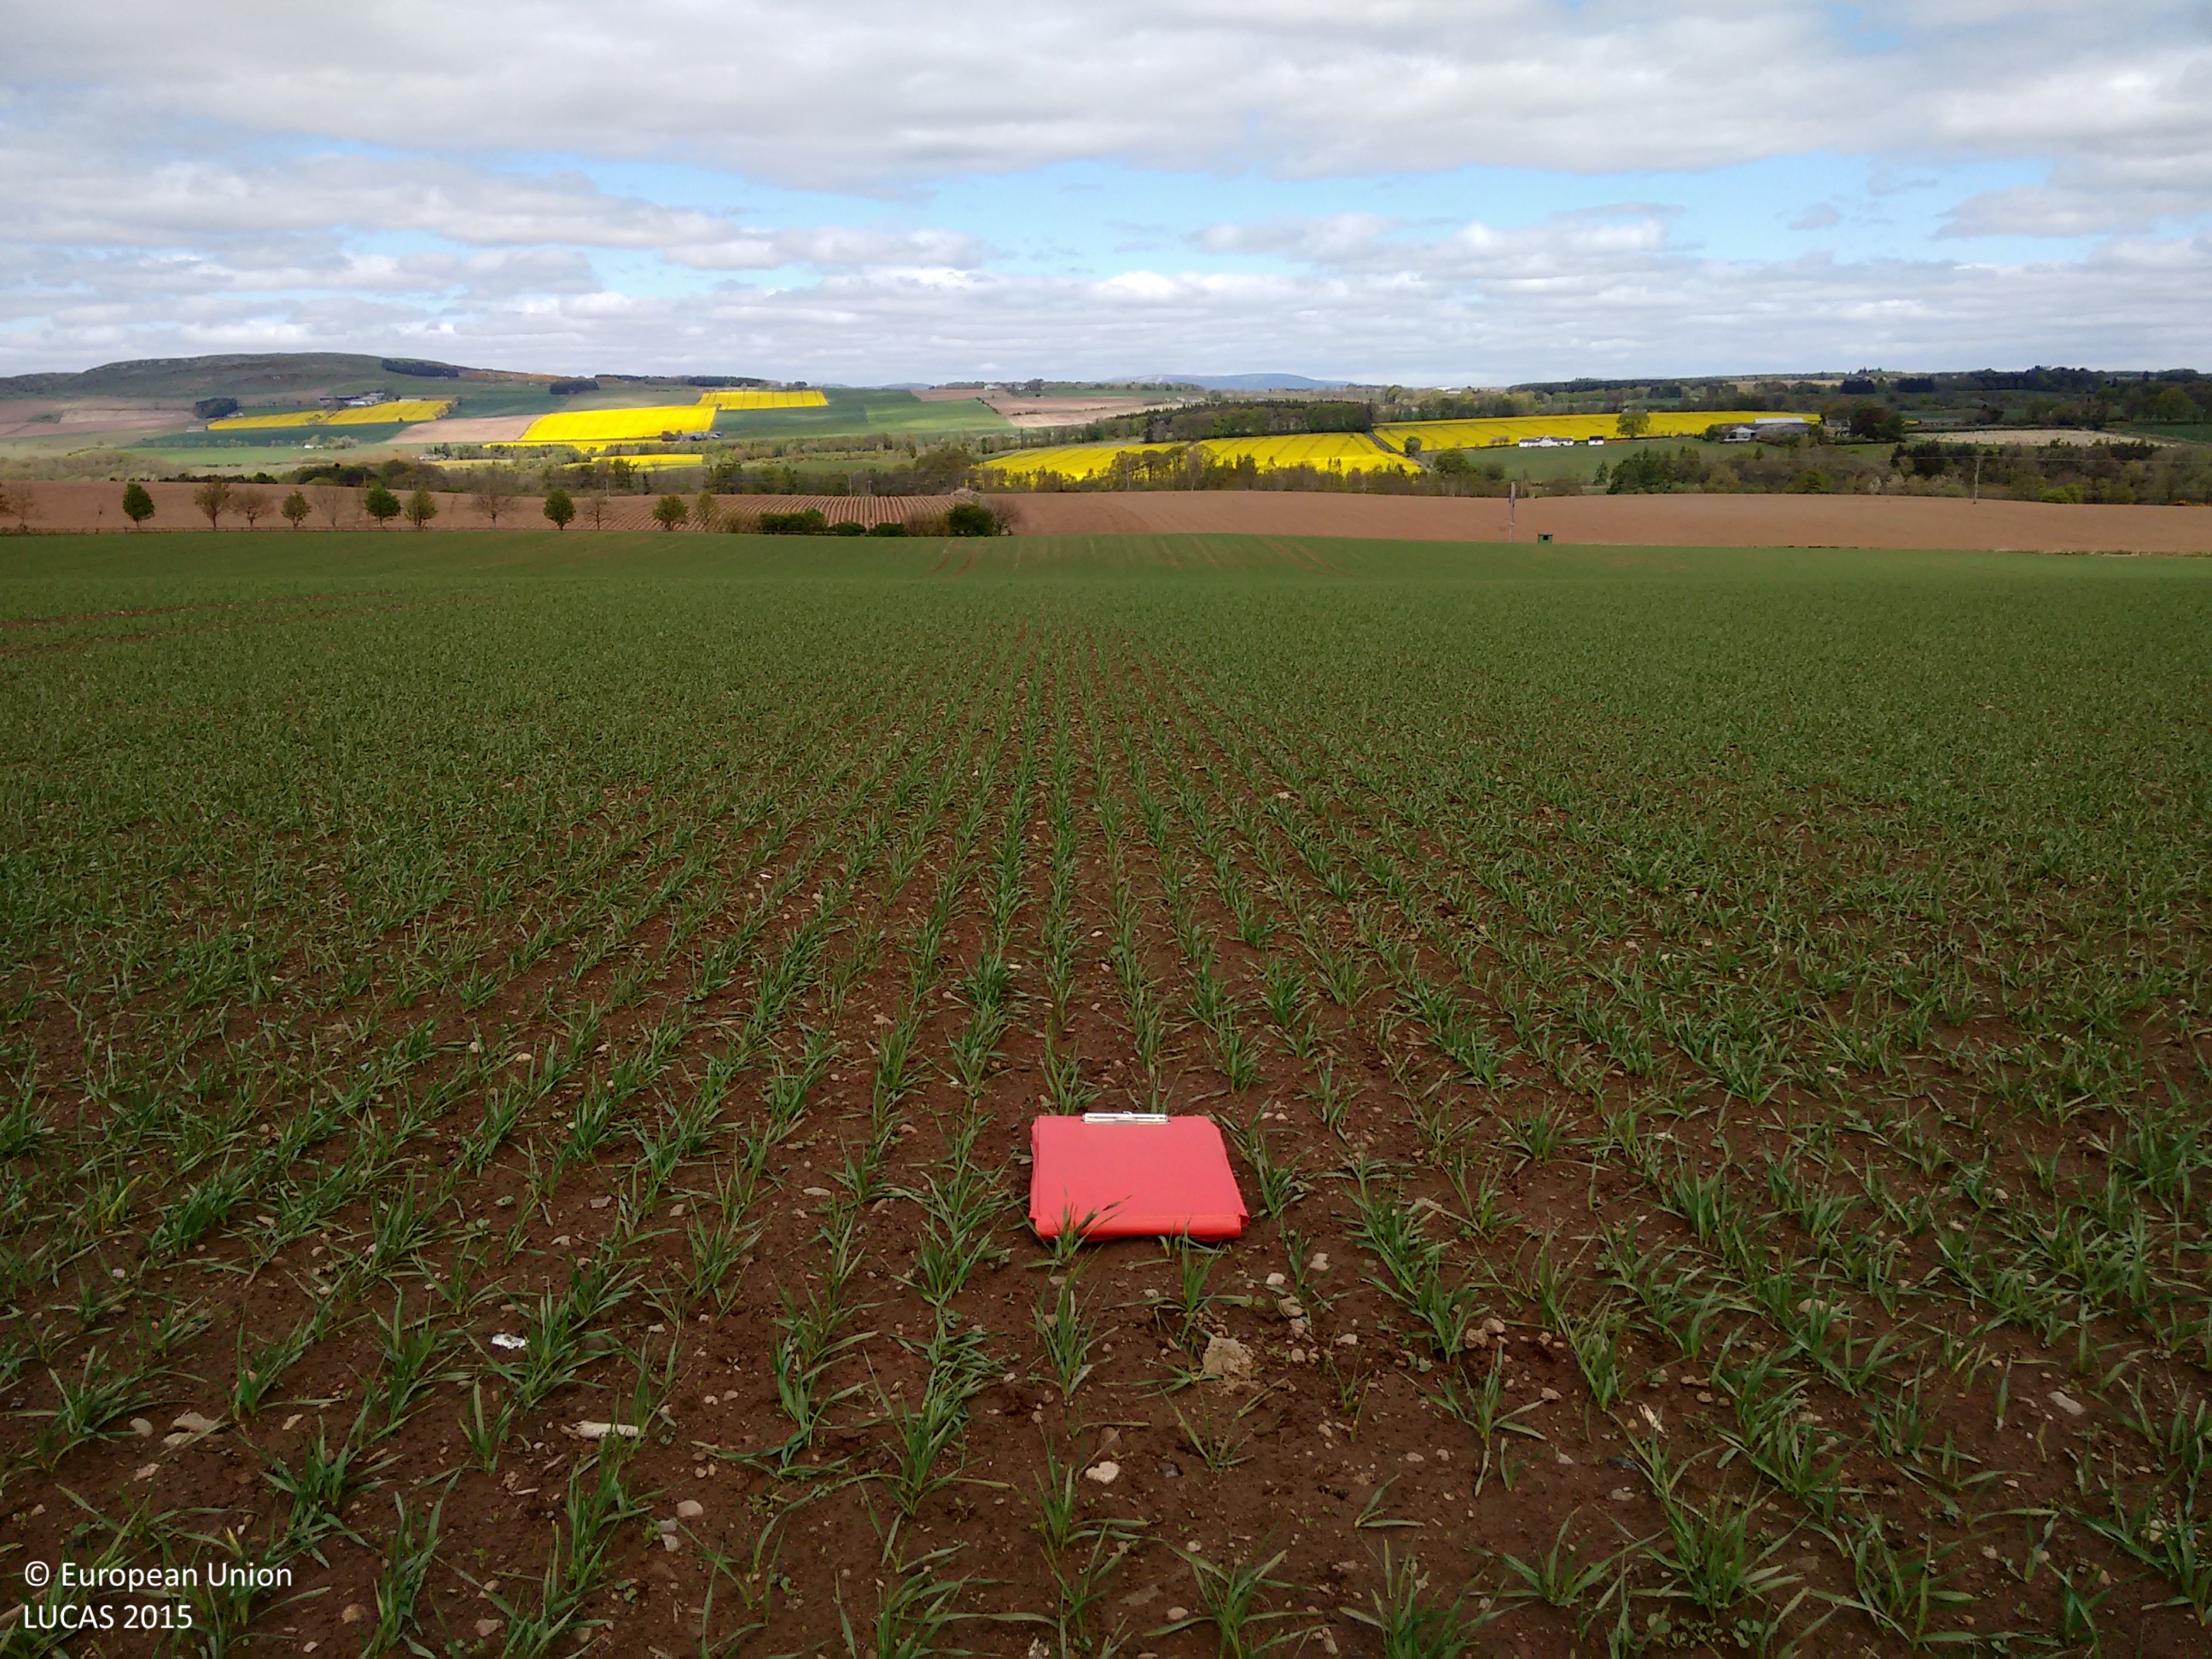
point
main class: Cropland
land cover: Barley
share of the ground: 25 - 50 %
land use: Agriculture (excluding fallow land and kitchen gardens)
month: May
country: GB
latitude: 56.6410
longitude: -2.7634
